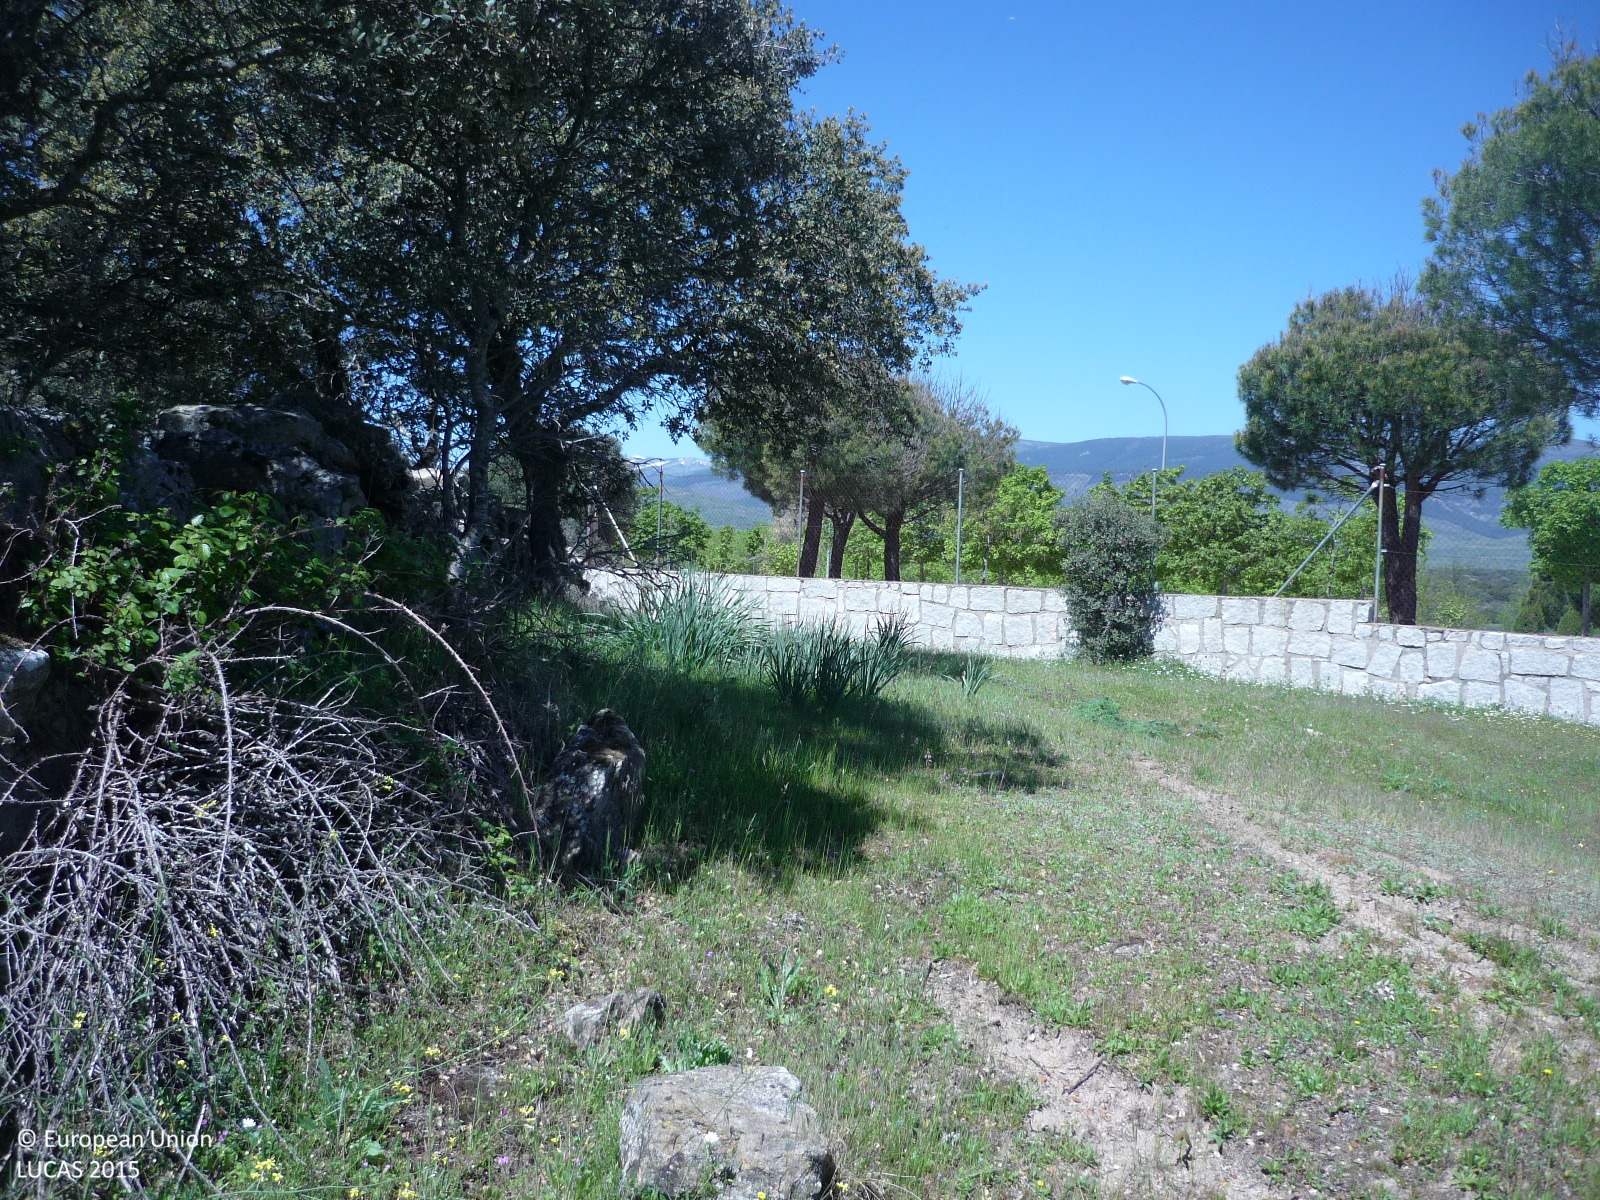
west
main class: Woodland
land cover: Broadleaved woodland
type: broadleaved evergreen forest
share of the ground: > 75 %
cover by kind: broadleaved forest trees 85 %, shrubs 10 %, herbaceous plants 5 %
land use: Forestry
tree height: < 5 m
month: May
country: ES
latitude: 40.9747
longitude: -3.6510
